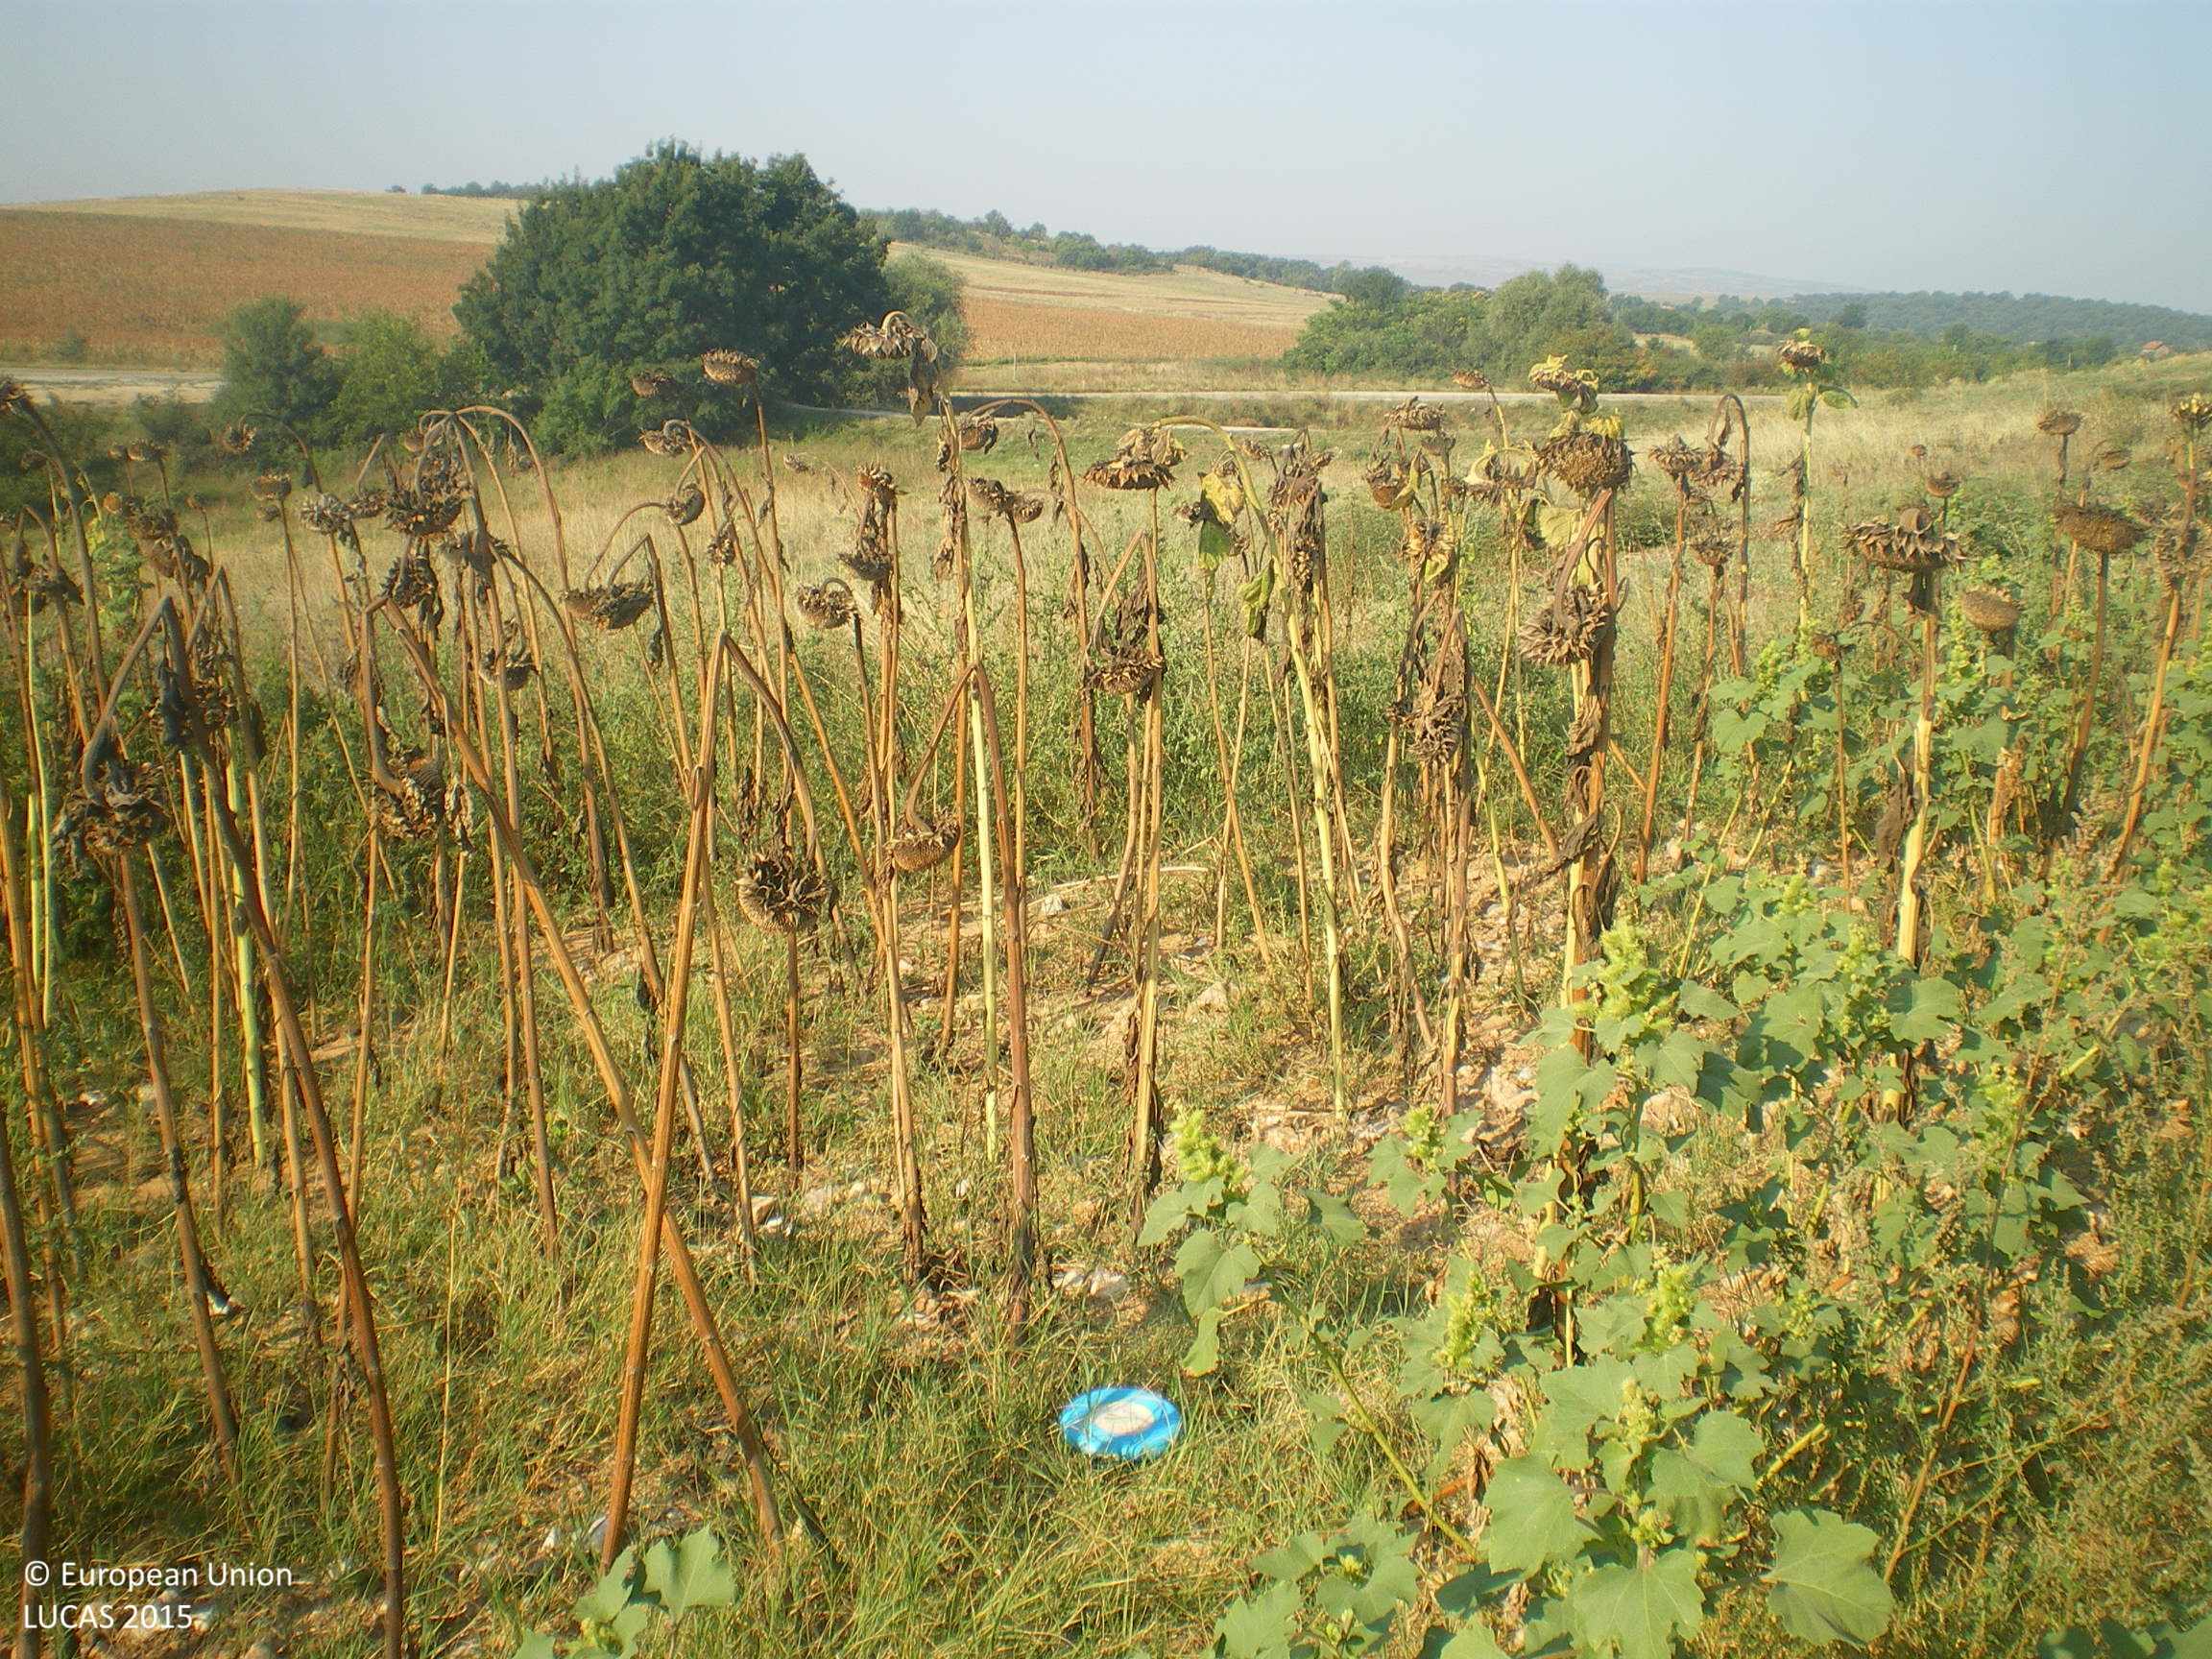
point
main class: Cropland
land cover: Sunflower
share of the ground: > 75 %
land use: Agriculture (excluding fallow land and kitchen gardens)
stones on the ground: > 50 %
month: August
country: BG
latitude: 42.0266
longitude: 25.9315
